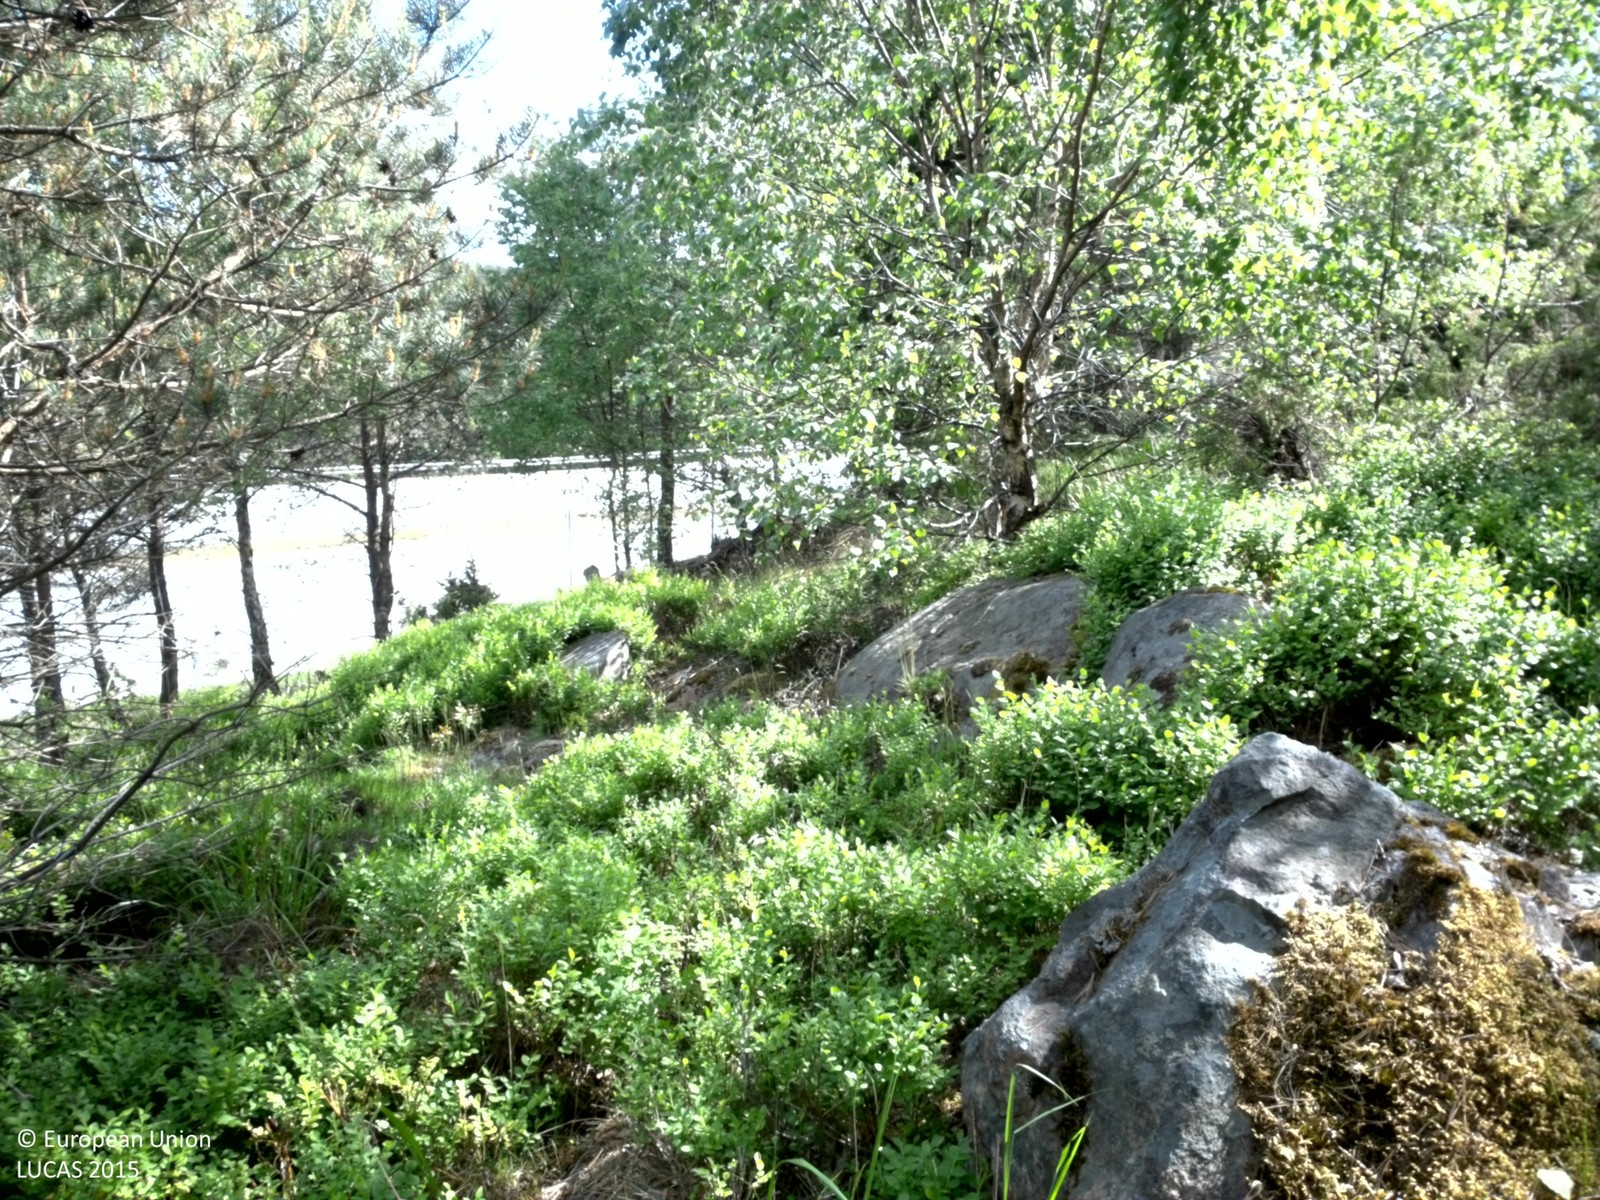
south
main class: Woodland
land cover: Pine dominated coniferous woodland
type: boreal forest
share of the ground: 10 - 25 %
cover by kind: shrubs 50 %, coniferous forest trees 20 %, lichens and mosses 20 %, broadleaved forest trees 5 %, herbaceous plants 5 %
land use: Forestry
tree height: < 5 m
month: June
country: SE
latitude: 58.6843
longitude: 16.3257
